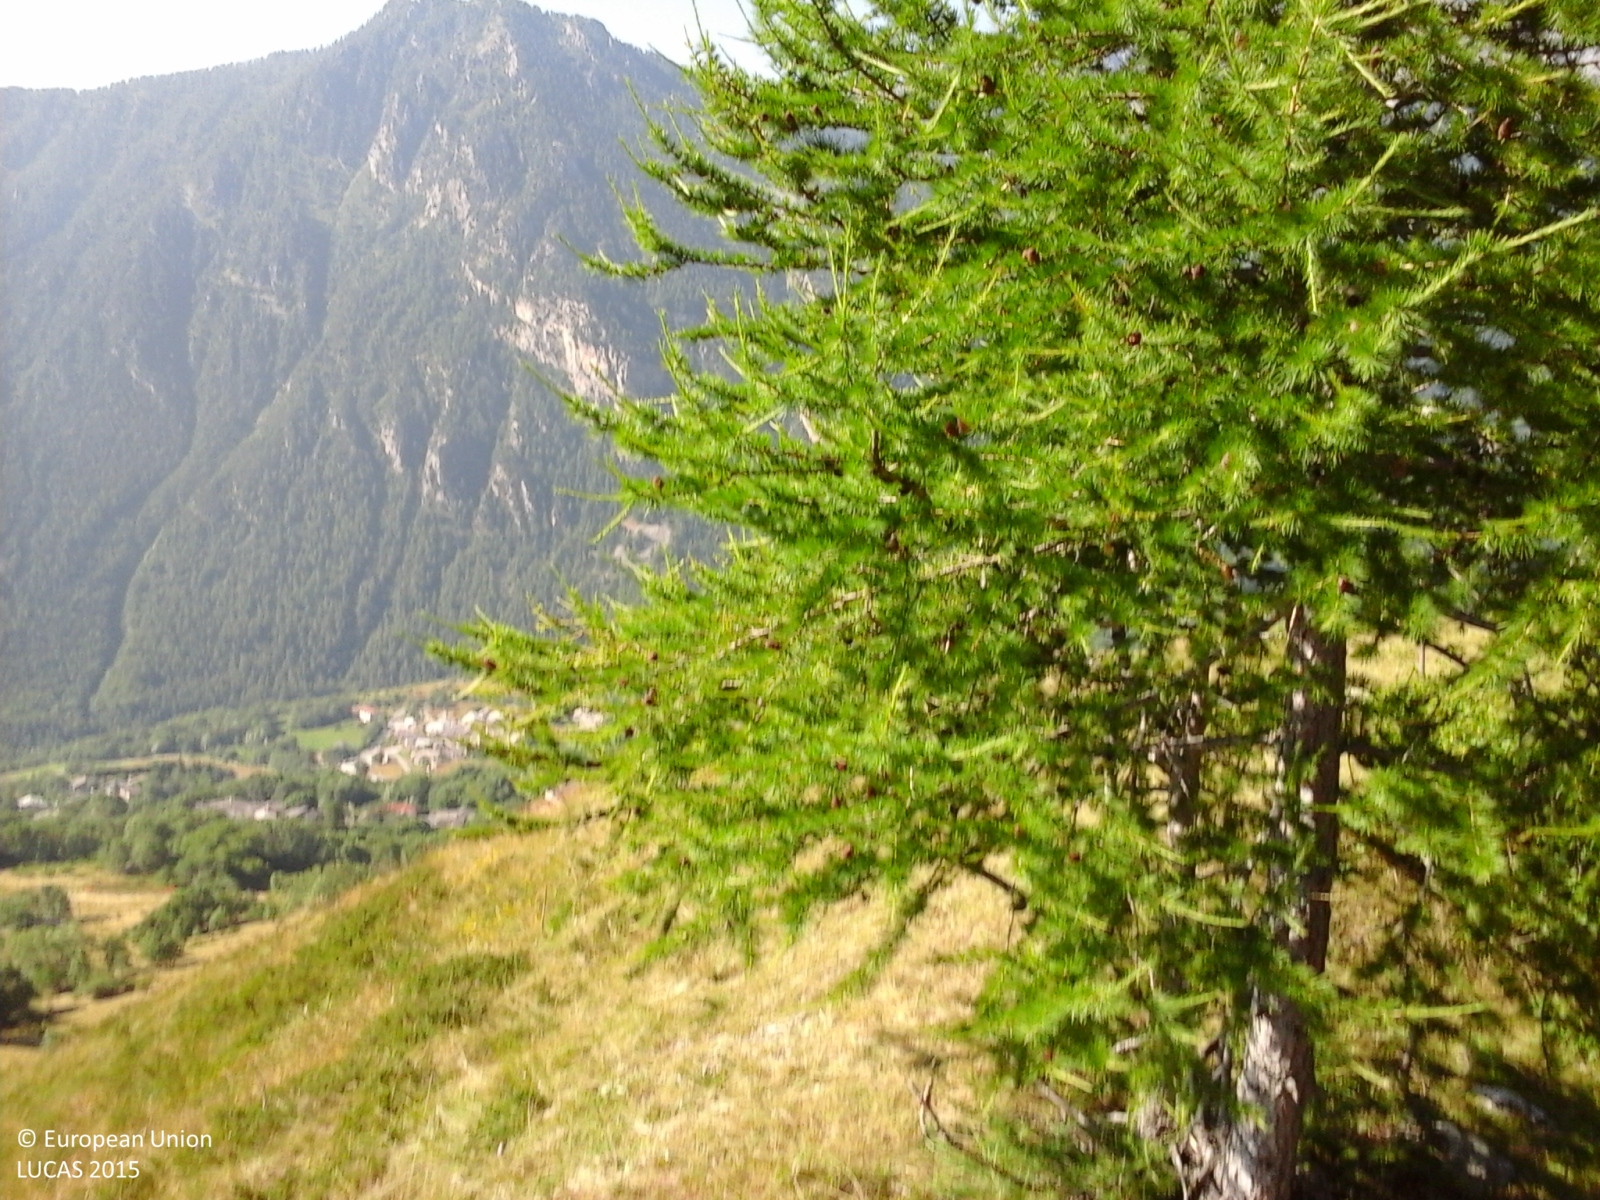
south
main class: Grassland
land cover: Grassland without tree/shrub cover
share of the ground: > 75 %
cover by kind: herbaceous plants 90 %, consolidated bare surface 10 %
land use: Agriculture (excluding fallow land and kitchen gardens)
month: July
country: IT
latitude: 44.4870
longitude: 6.9755
